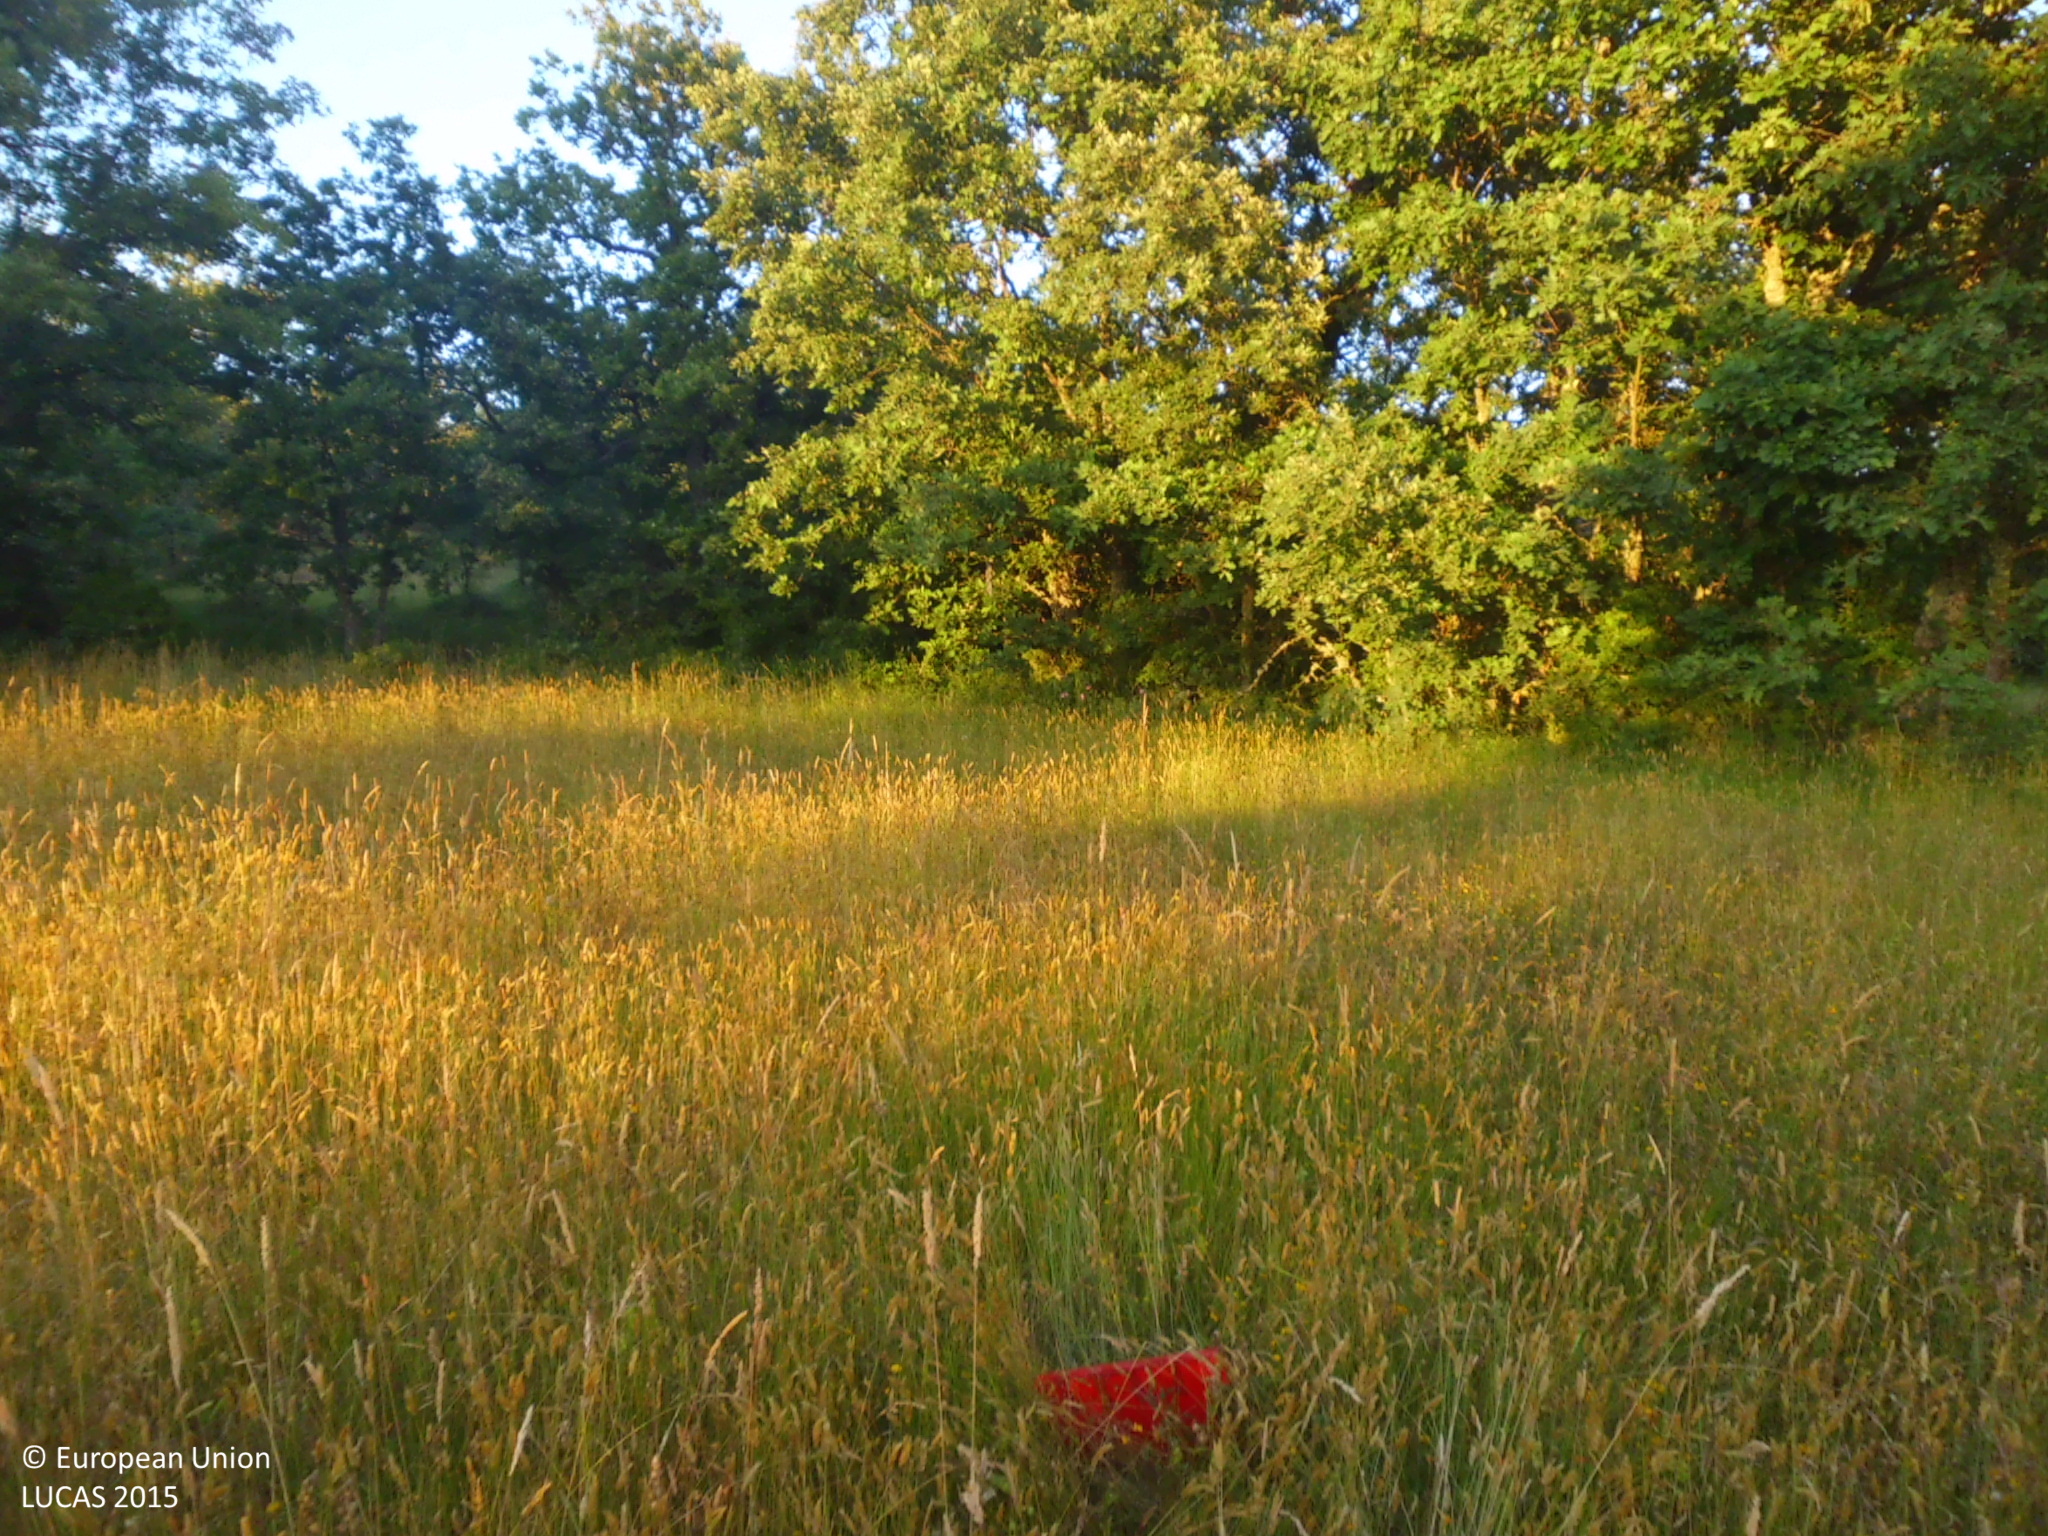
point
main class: Grassland
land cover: Spontaneously vegetated surfaces
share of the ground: > 75 %
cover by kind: herbaceous plants 100 %
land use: Fallow land
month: June
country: ES
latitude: 42.6194
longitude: -3.9291
